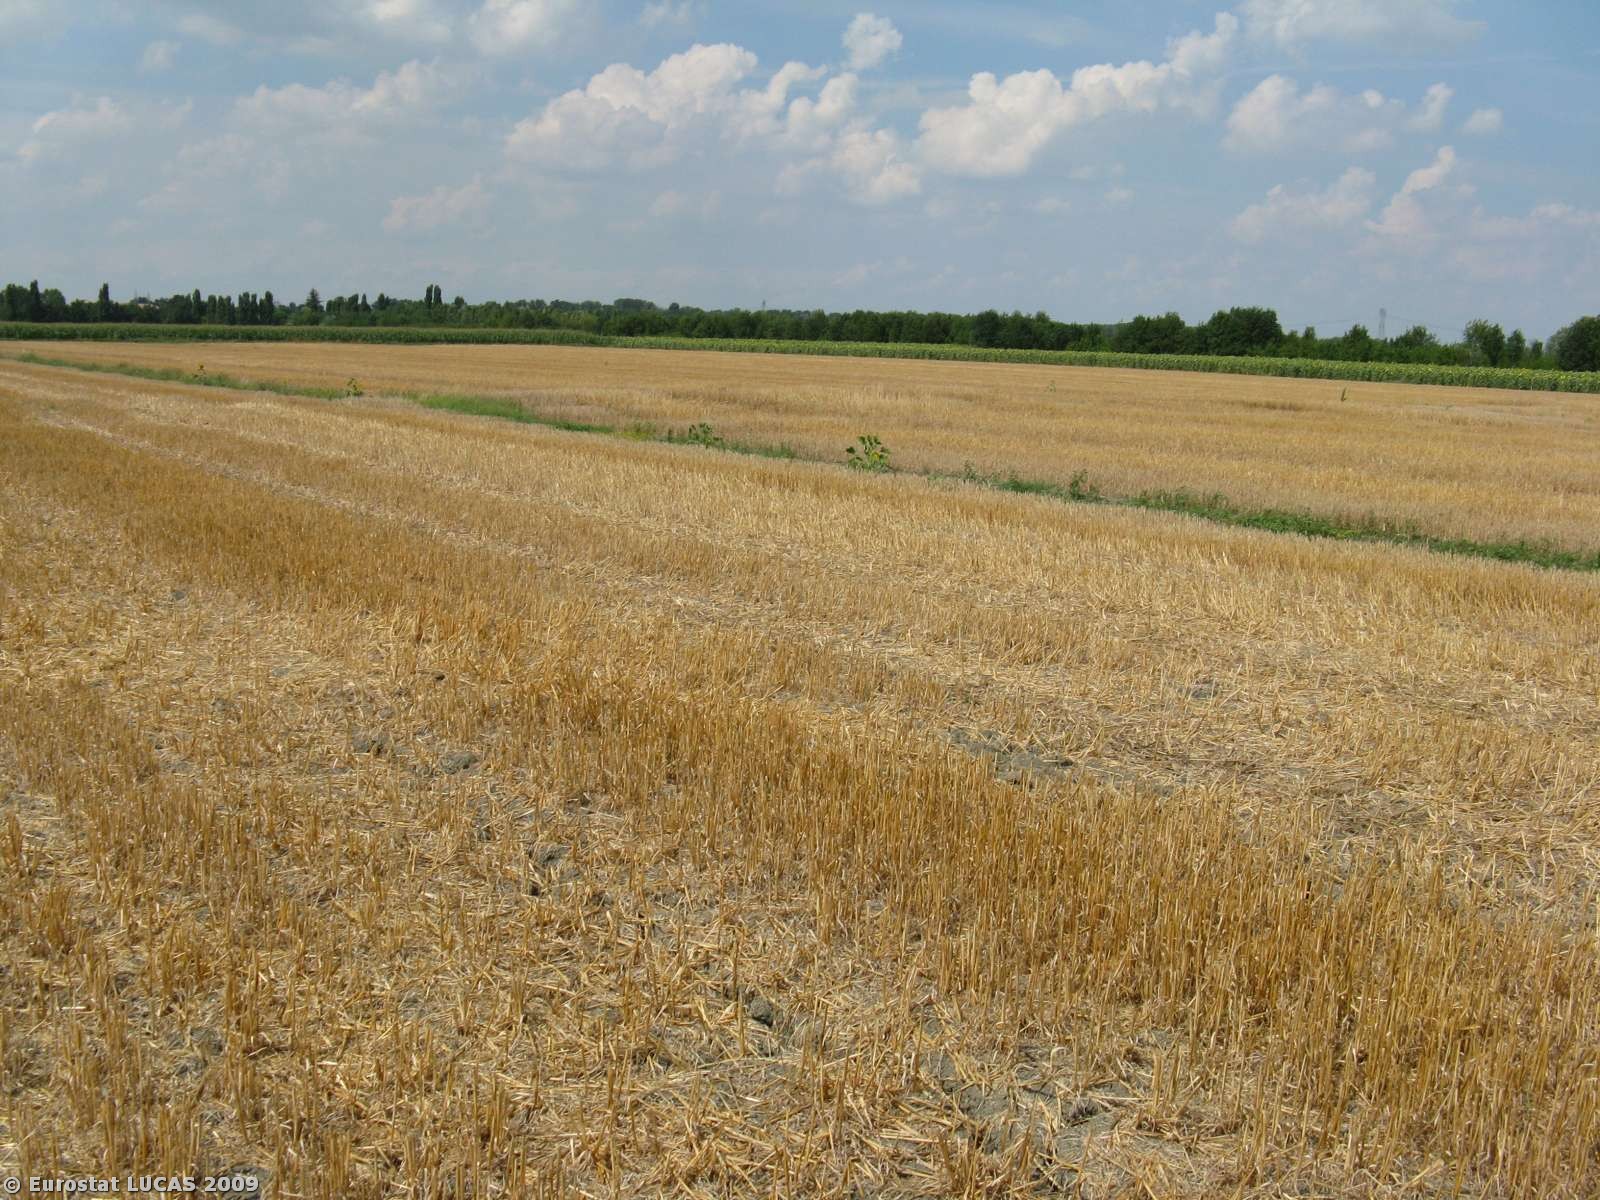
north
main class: Cropland
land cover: Common wheat
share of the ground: < 10 %
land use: Agriculture (excluding fallow land and kitchen gardens)
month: July
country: IT
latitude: 44.5540
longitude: 11.6456
